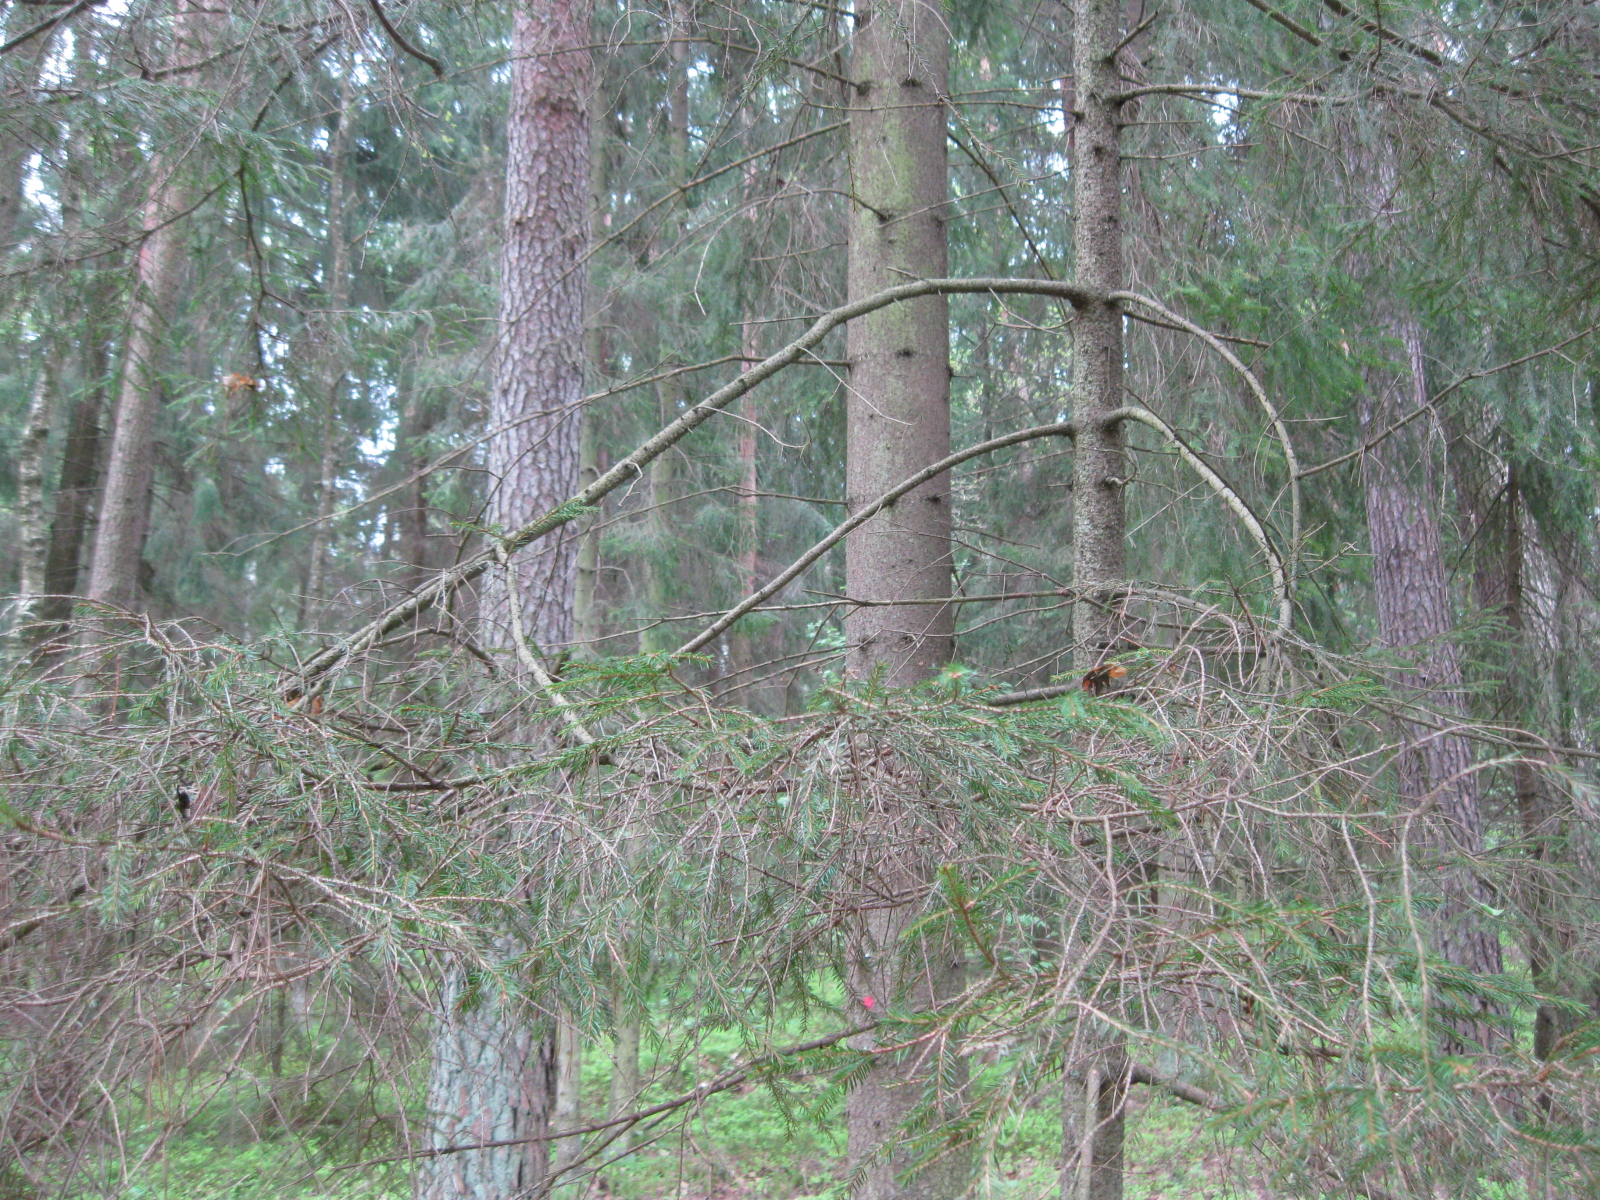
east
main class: Woodland
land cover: Other mixed woodland
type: hemiboreal forest and nemoral coniferous forest and mixed broadleaved-coniferous forest
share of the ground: > 75 %
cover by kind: coniferous forest trees 45 %, broadleaved forest trees 40 %, shrubs 5 %, herbaceous plants 5 %, lichens and mosses 5 %
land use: Forestry
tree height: > 5 m
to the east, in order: Other mixed woodland; Tracks; Other mixed woodland; Tracks; Other mixed woodland; Broadleaved woodland
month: May
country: LT
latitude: 55.9588
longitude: 24.3671
